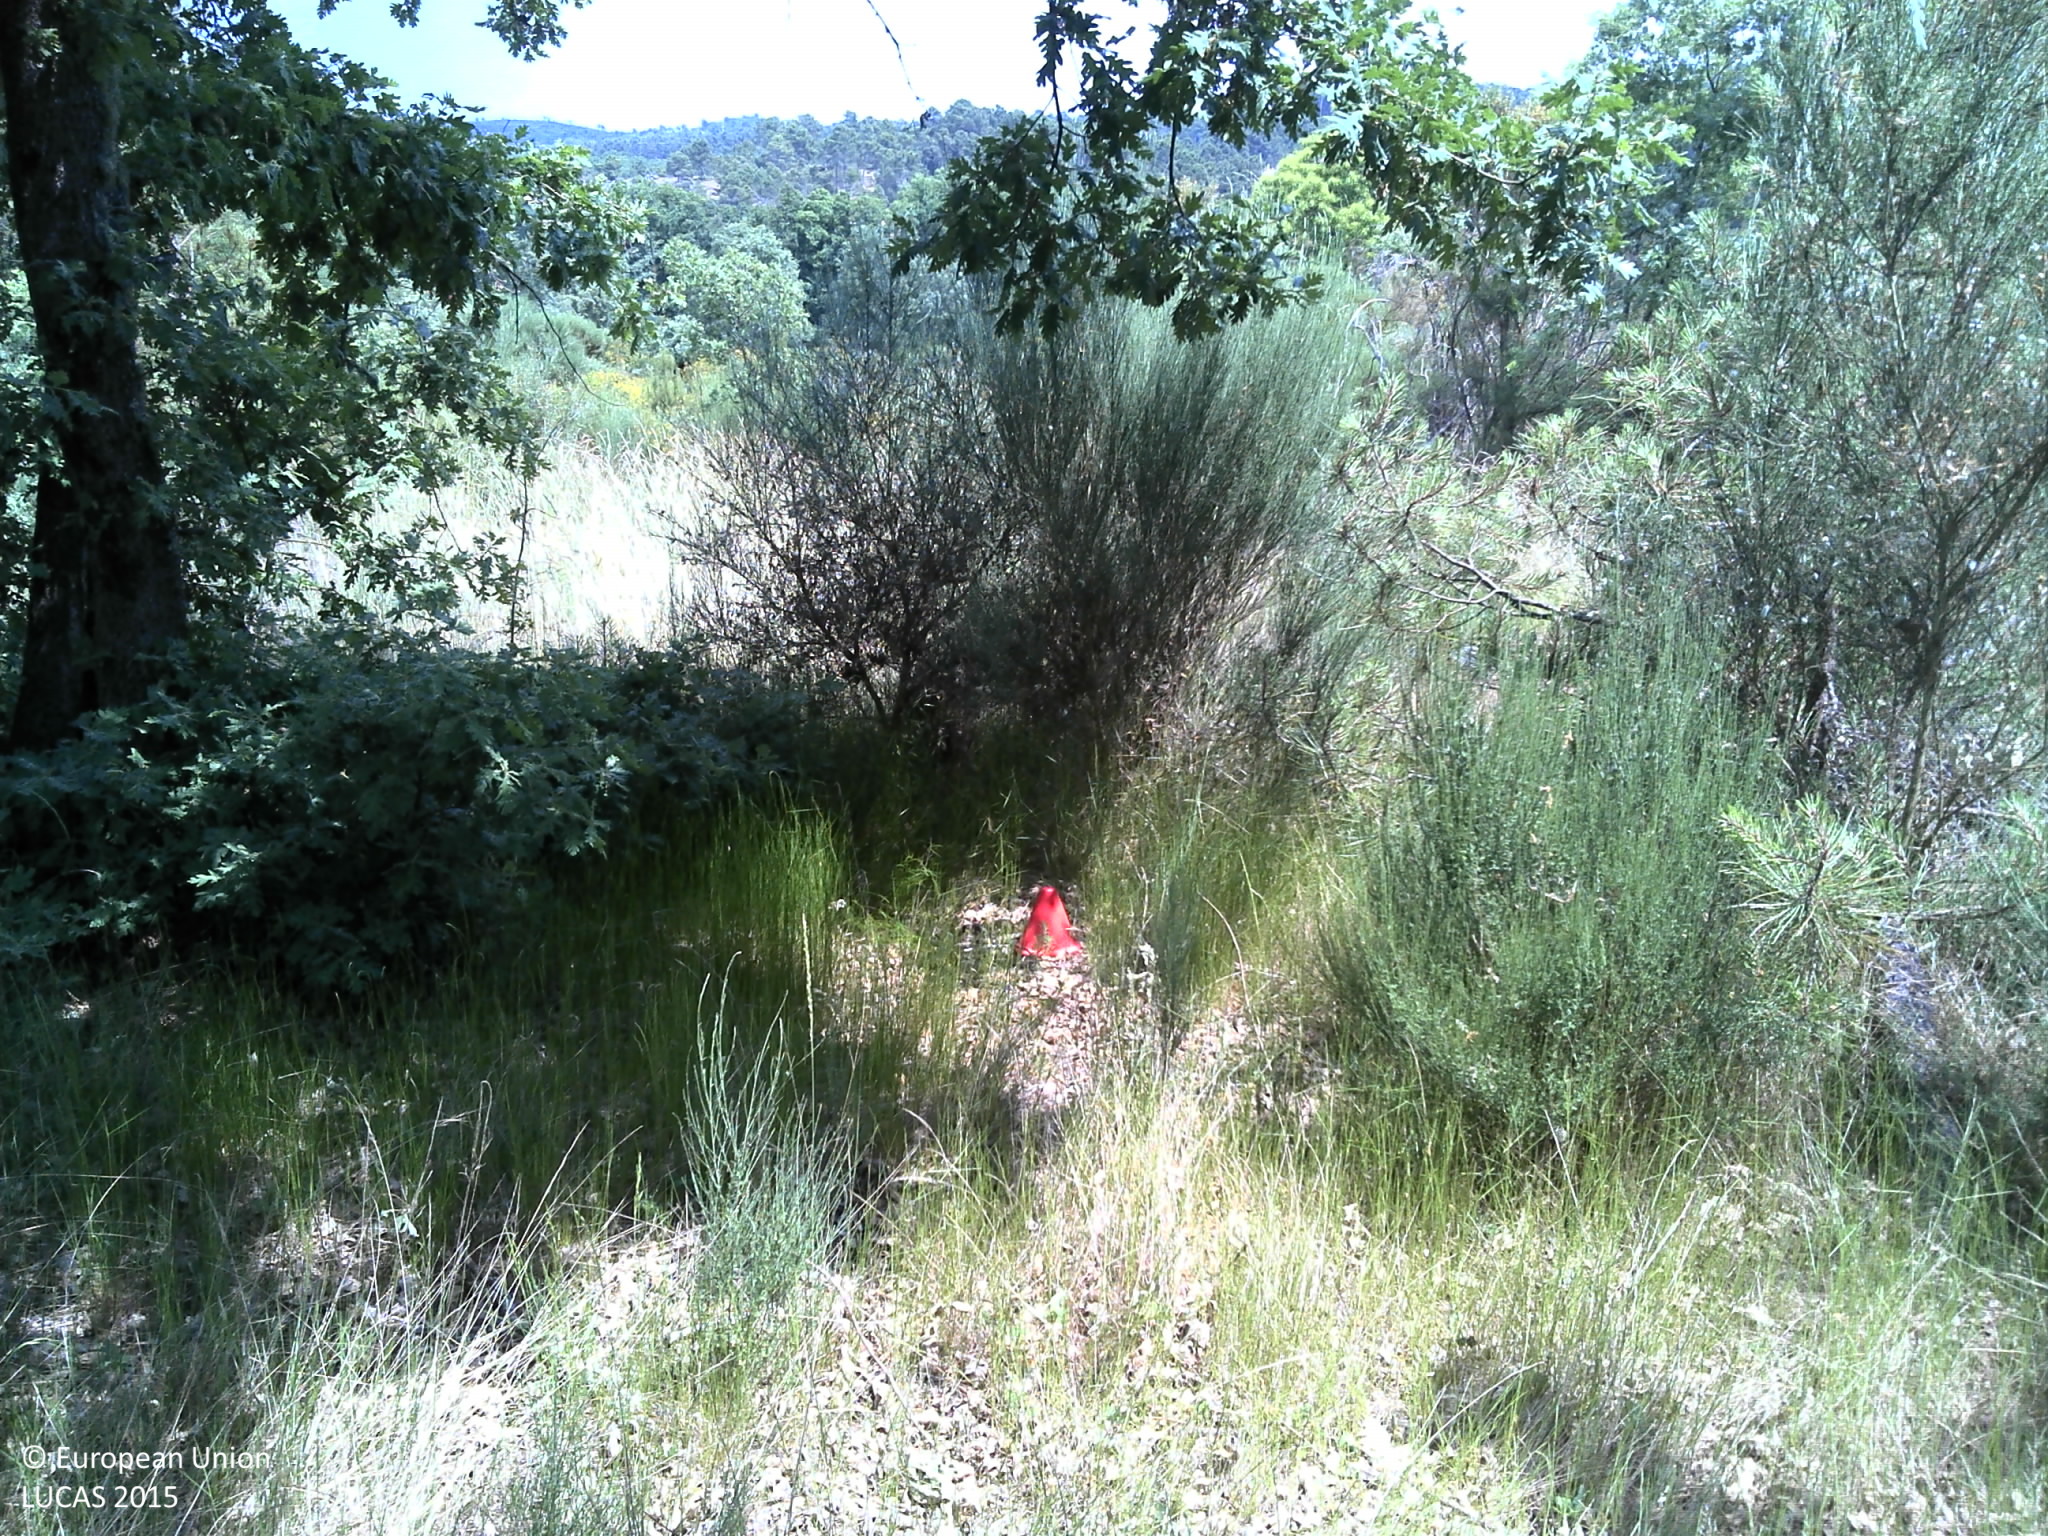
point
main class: Woodland
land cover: Broadleaved woodland
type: acidophilous oak and oak-birch forest
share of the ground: 25 - 50 %
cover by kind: herbaceous plants 60 %, broadleaved forest trees 25 %, shrubs 15 %
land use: Forestry
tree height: > 5 m
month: June
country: PT
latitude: 41.3457
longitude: -7.6614
